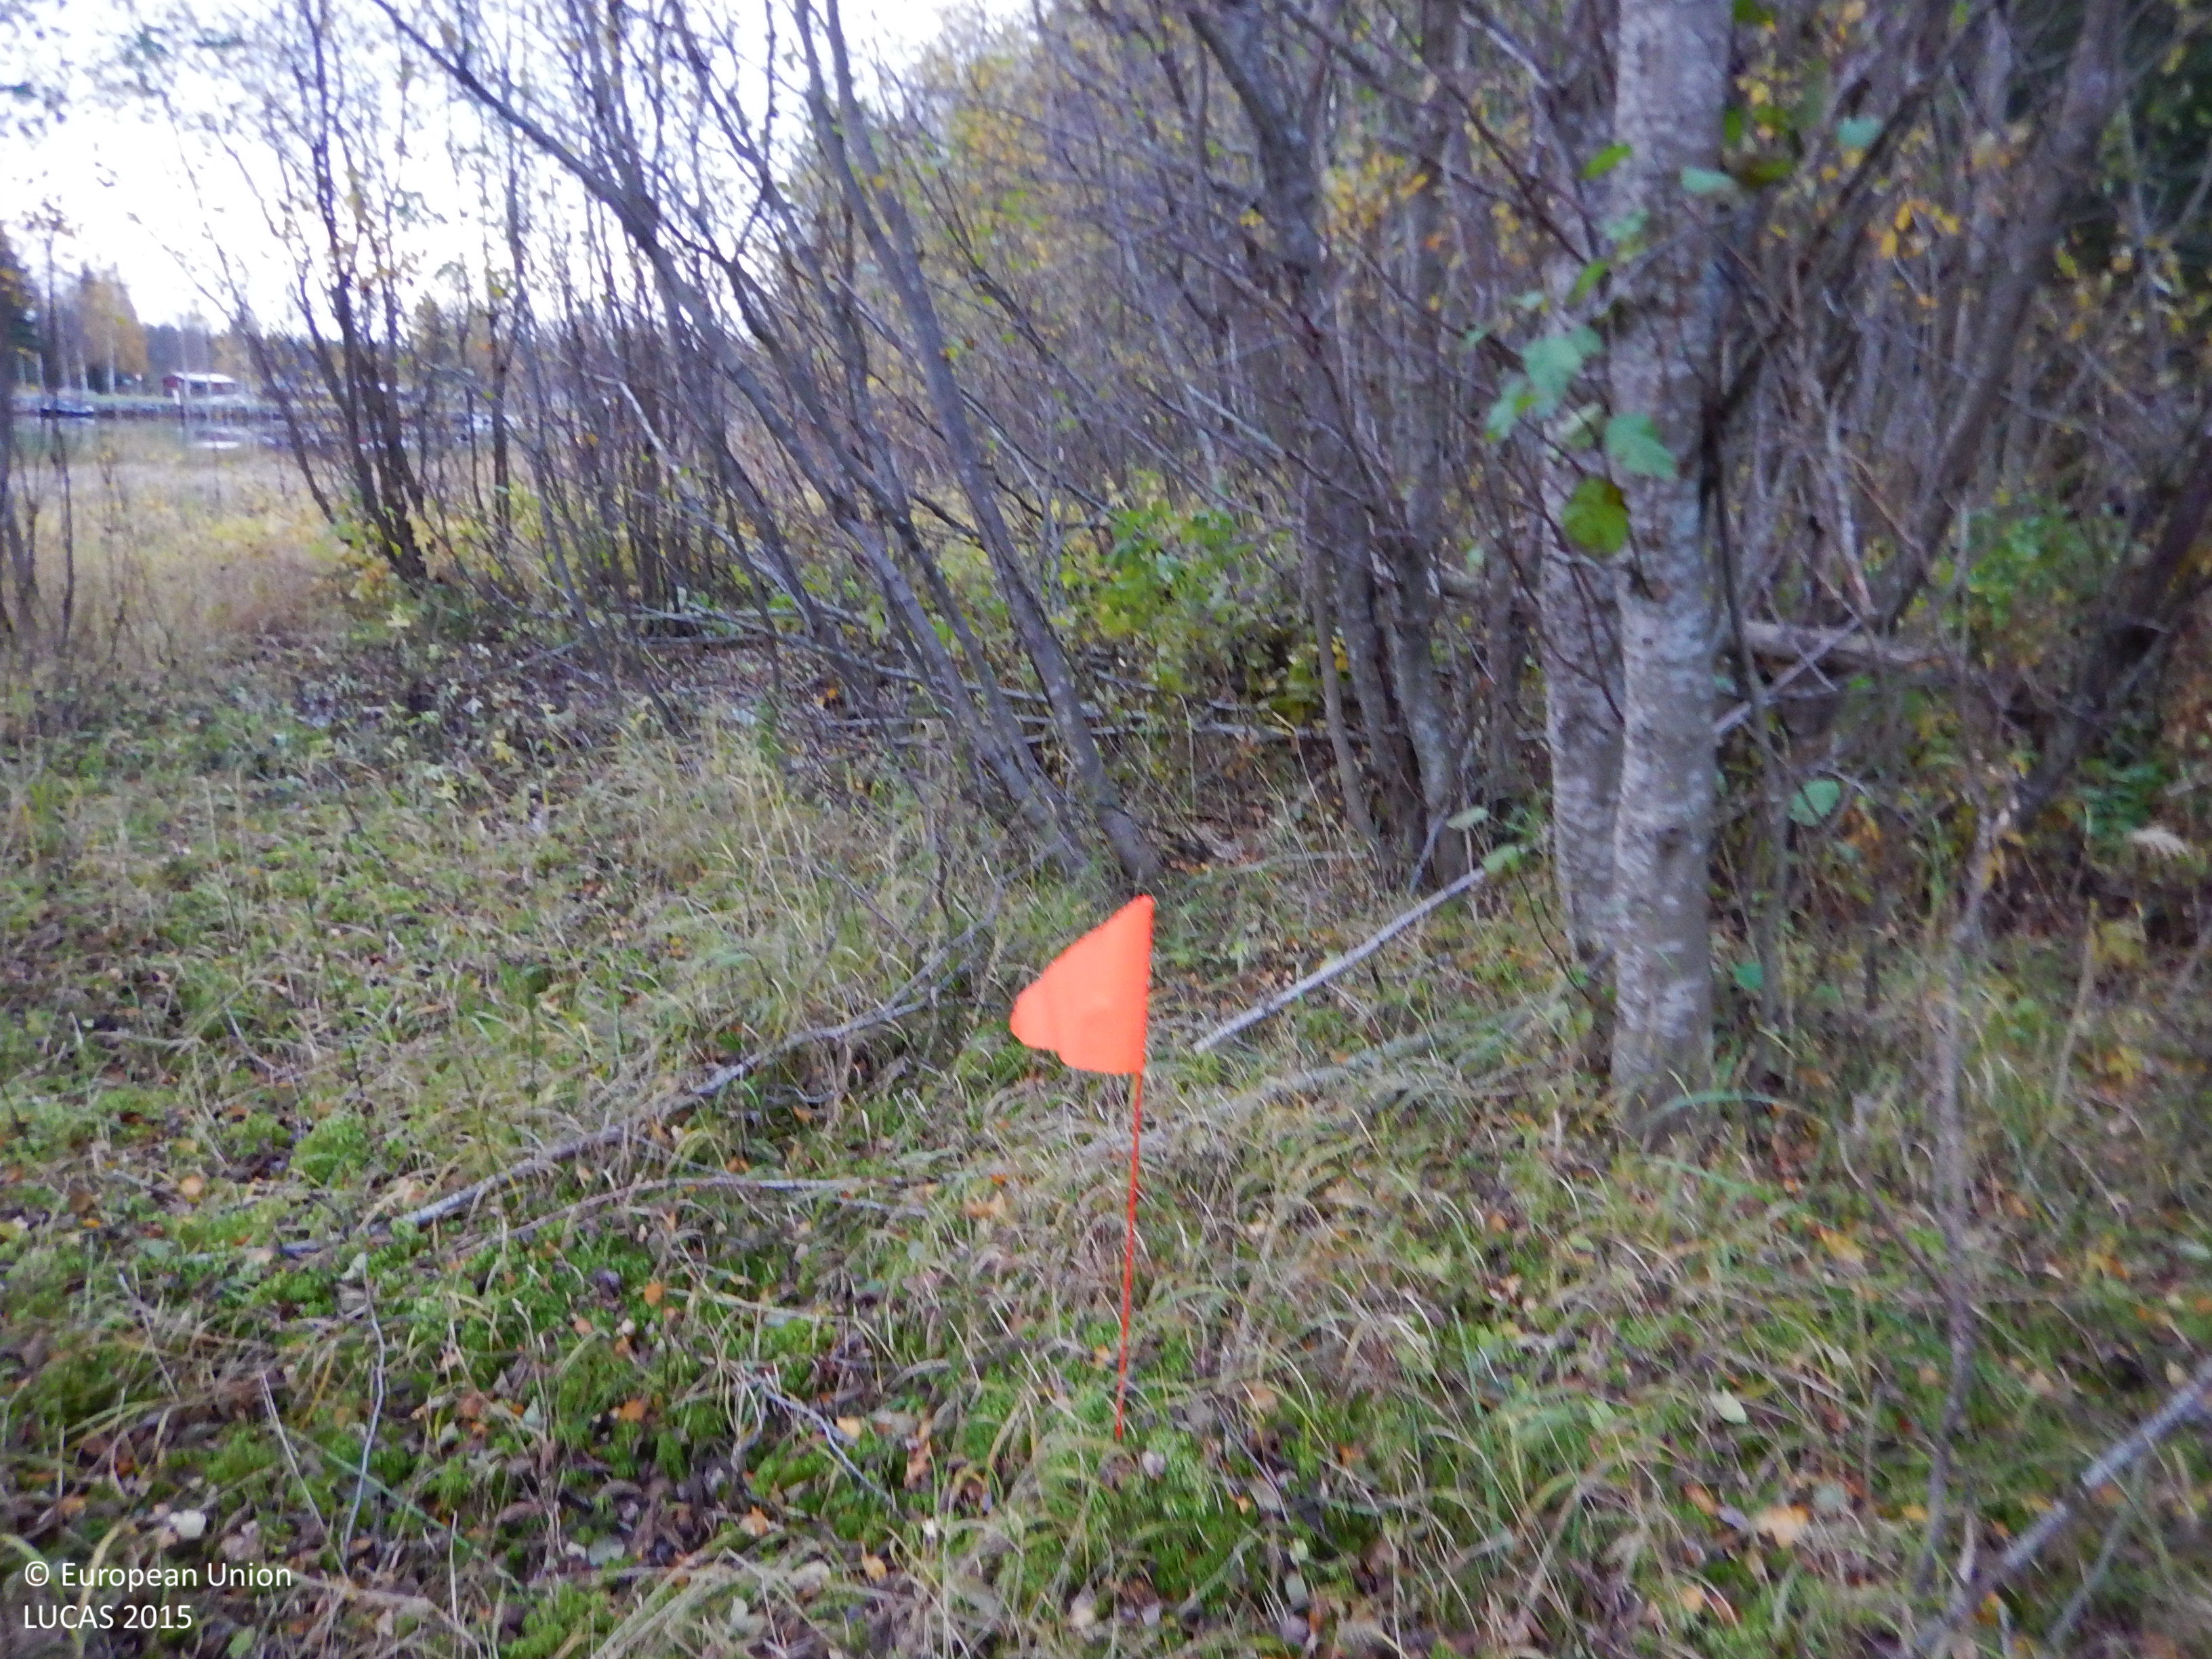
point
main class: Woodland
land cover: Broadleaved woodland
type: non-riverine alder, birch or aspen forest
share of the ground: 50 - 75 %
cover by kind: broadleaved forest trees 55 %, shrubs 20 %, herbaceous plants 10 %, lichens and mosses 10 %, coniferous forest trees 5 %
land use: Semi-natural and natural areas not in use
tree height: > 5 m
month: October
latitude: 64.8548
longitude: 21.0086
